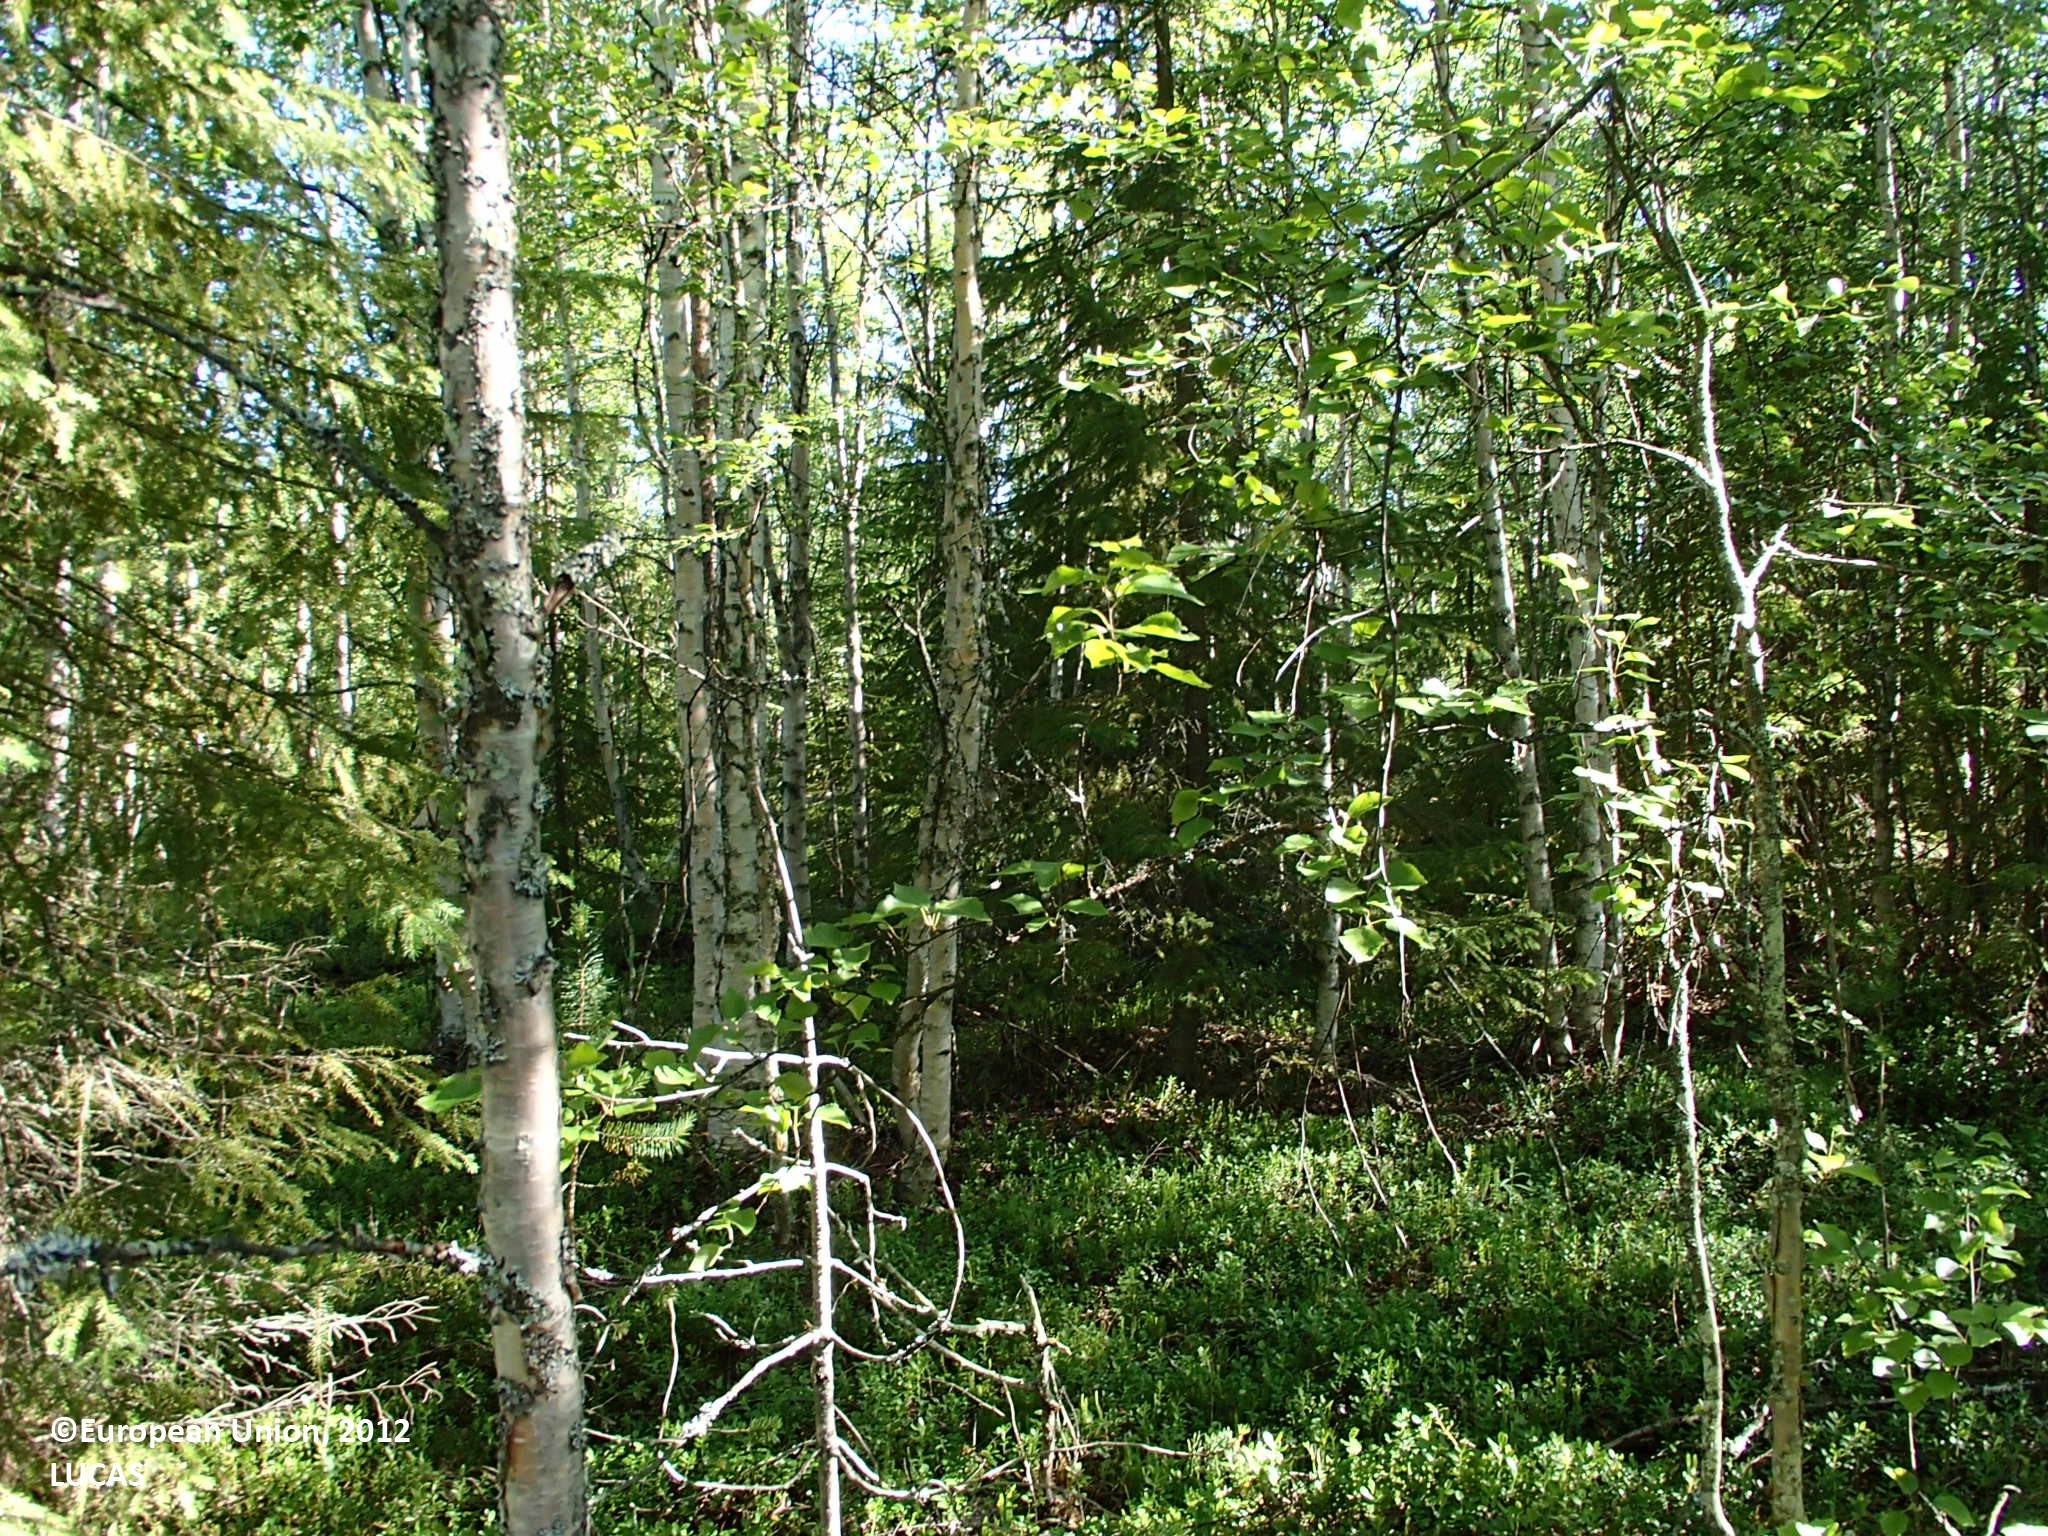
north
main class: Woodland
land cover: Other mixed woodland
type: boreal forest
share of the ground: > 75 %
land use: Forestry
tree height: > 5 m
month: July
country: FI
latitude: 66.8564
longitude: 25.4478
